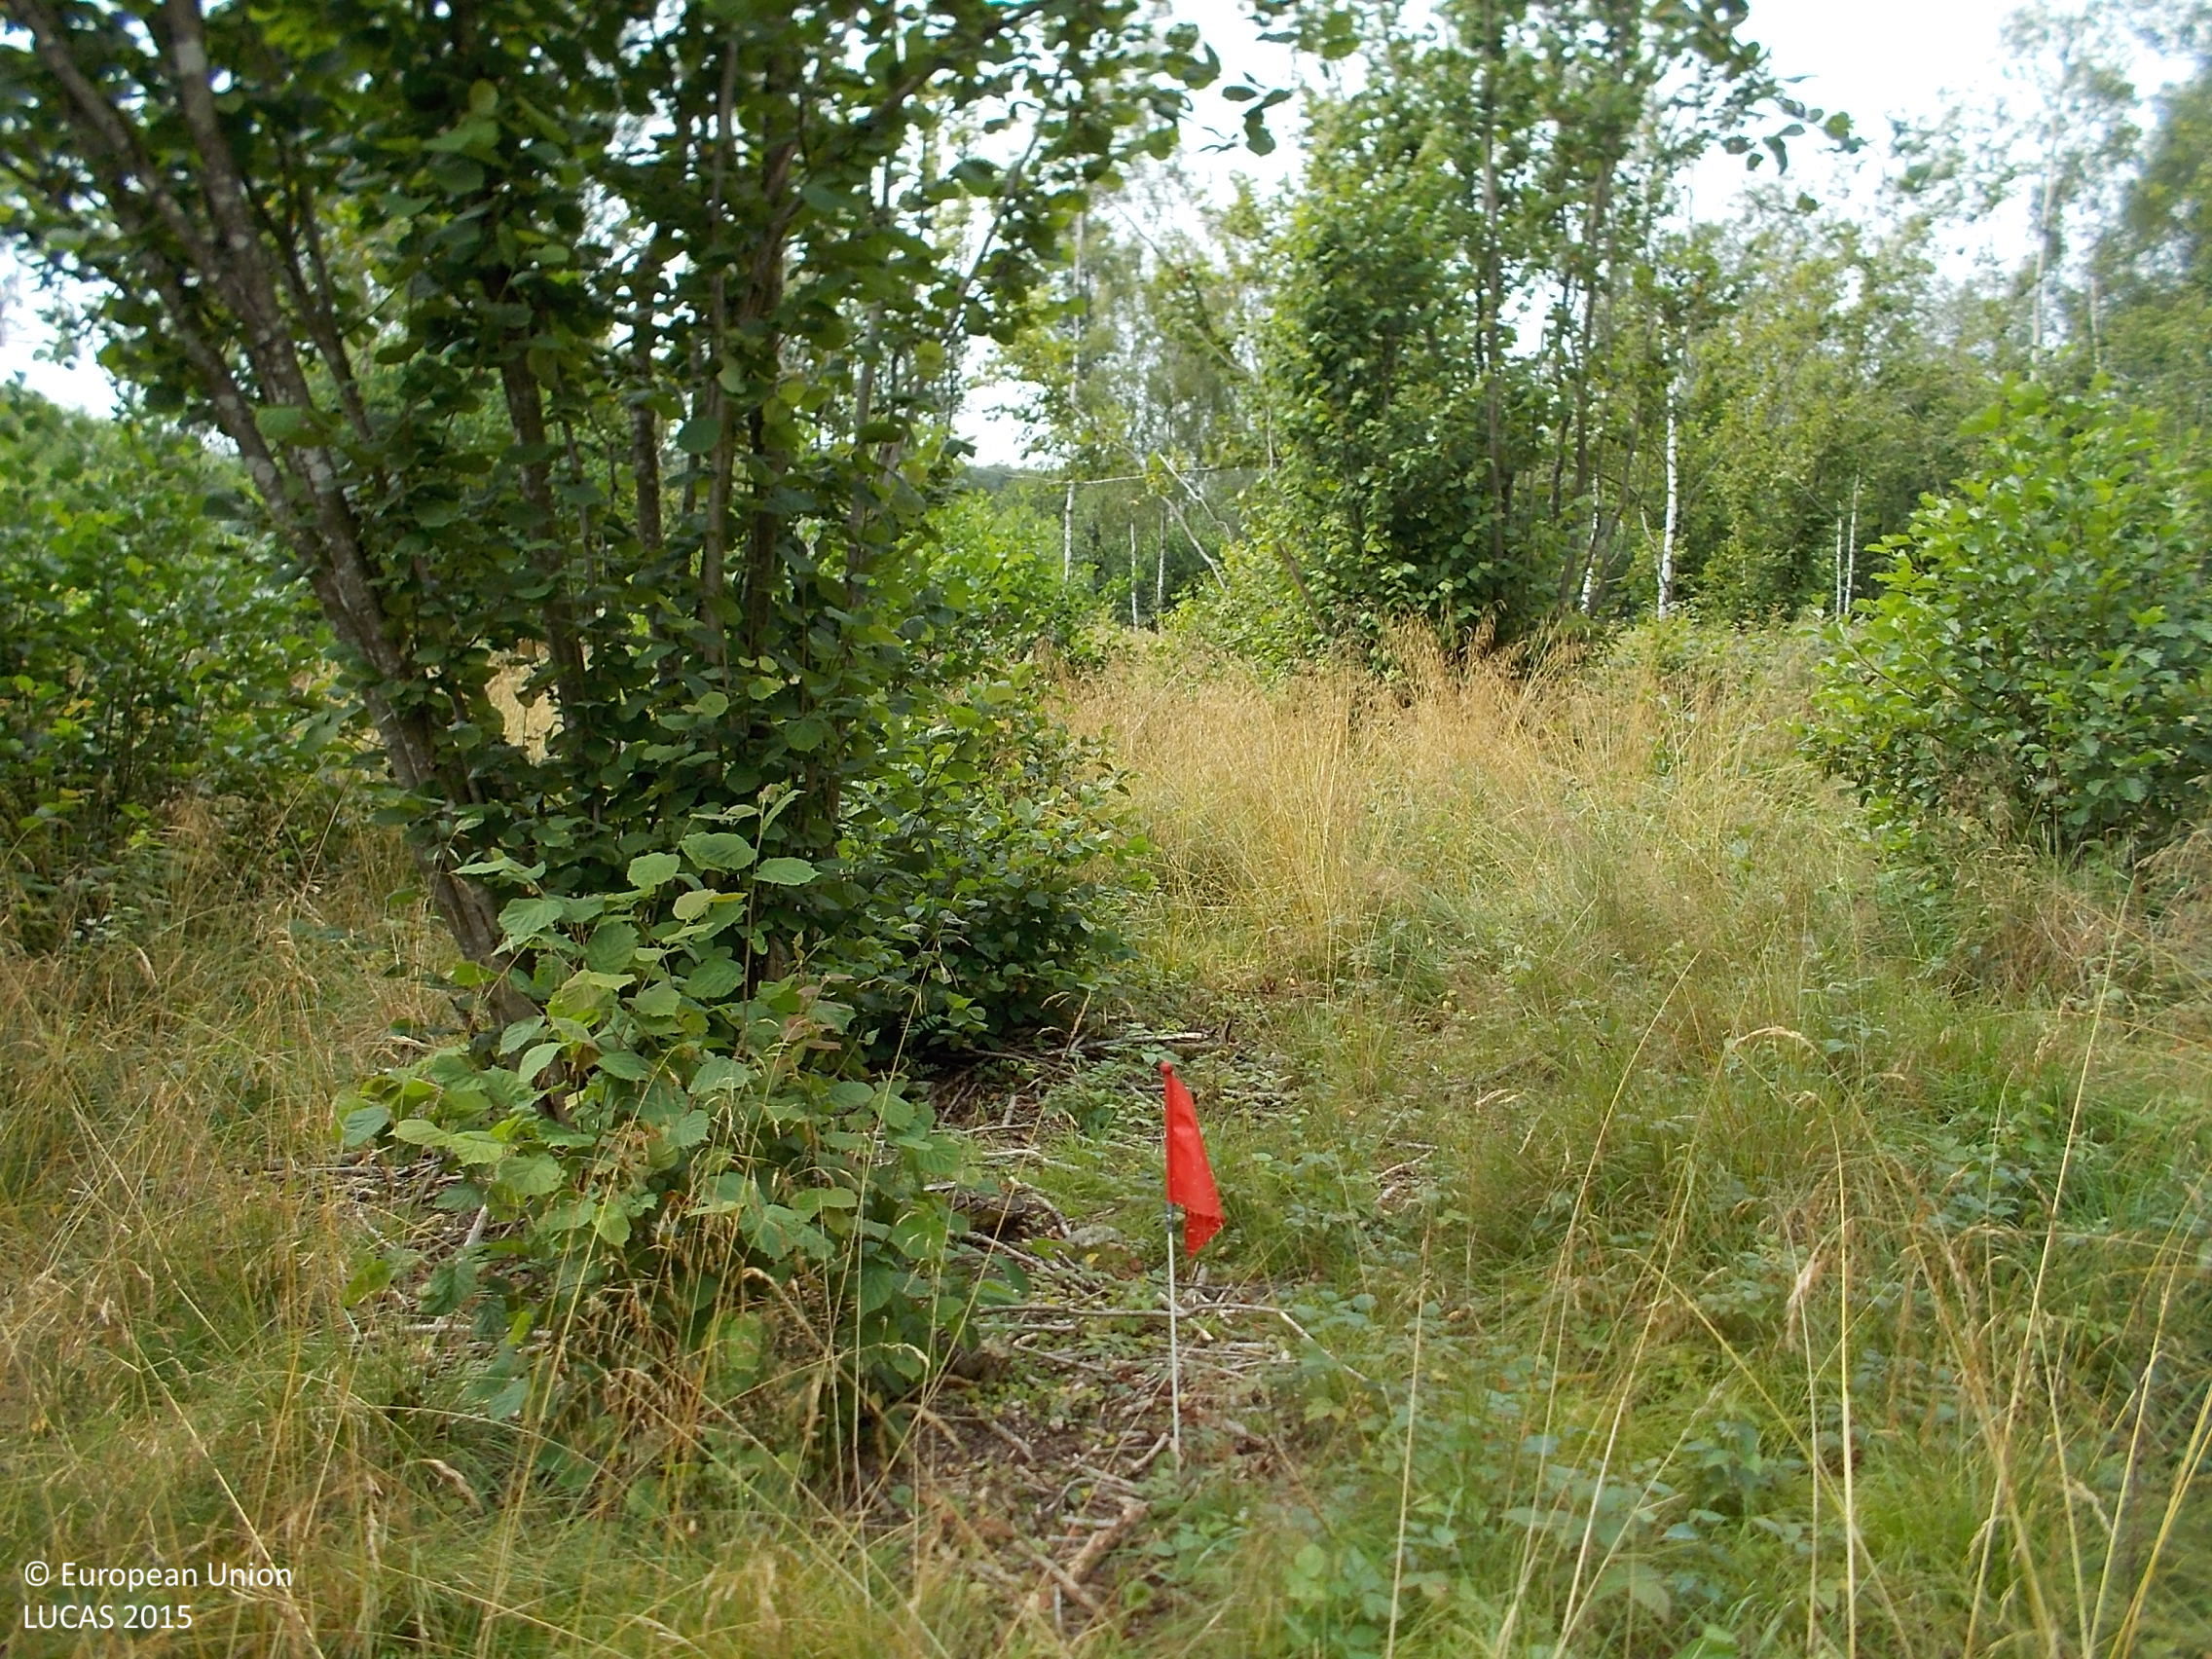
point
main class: Woodland
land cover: Broadleaved woodland
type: hemiboreal forest and nemoral coniferous forest and mixed broadleaved-coniferous forest
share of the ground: 25 - 50 %
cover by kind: broadleaved forest trees 50 %, shrubs 25 %, herbaceous plants 25 %
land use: Forestry
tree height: > 5 m
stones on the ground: < 10 %
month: August
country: SE
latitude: 57.4811
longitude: 12.2482
